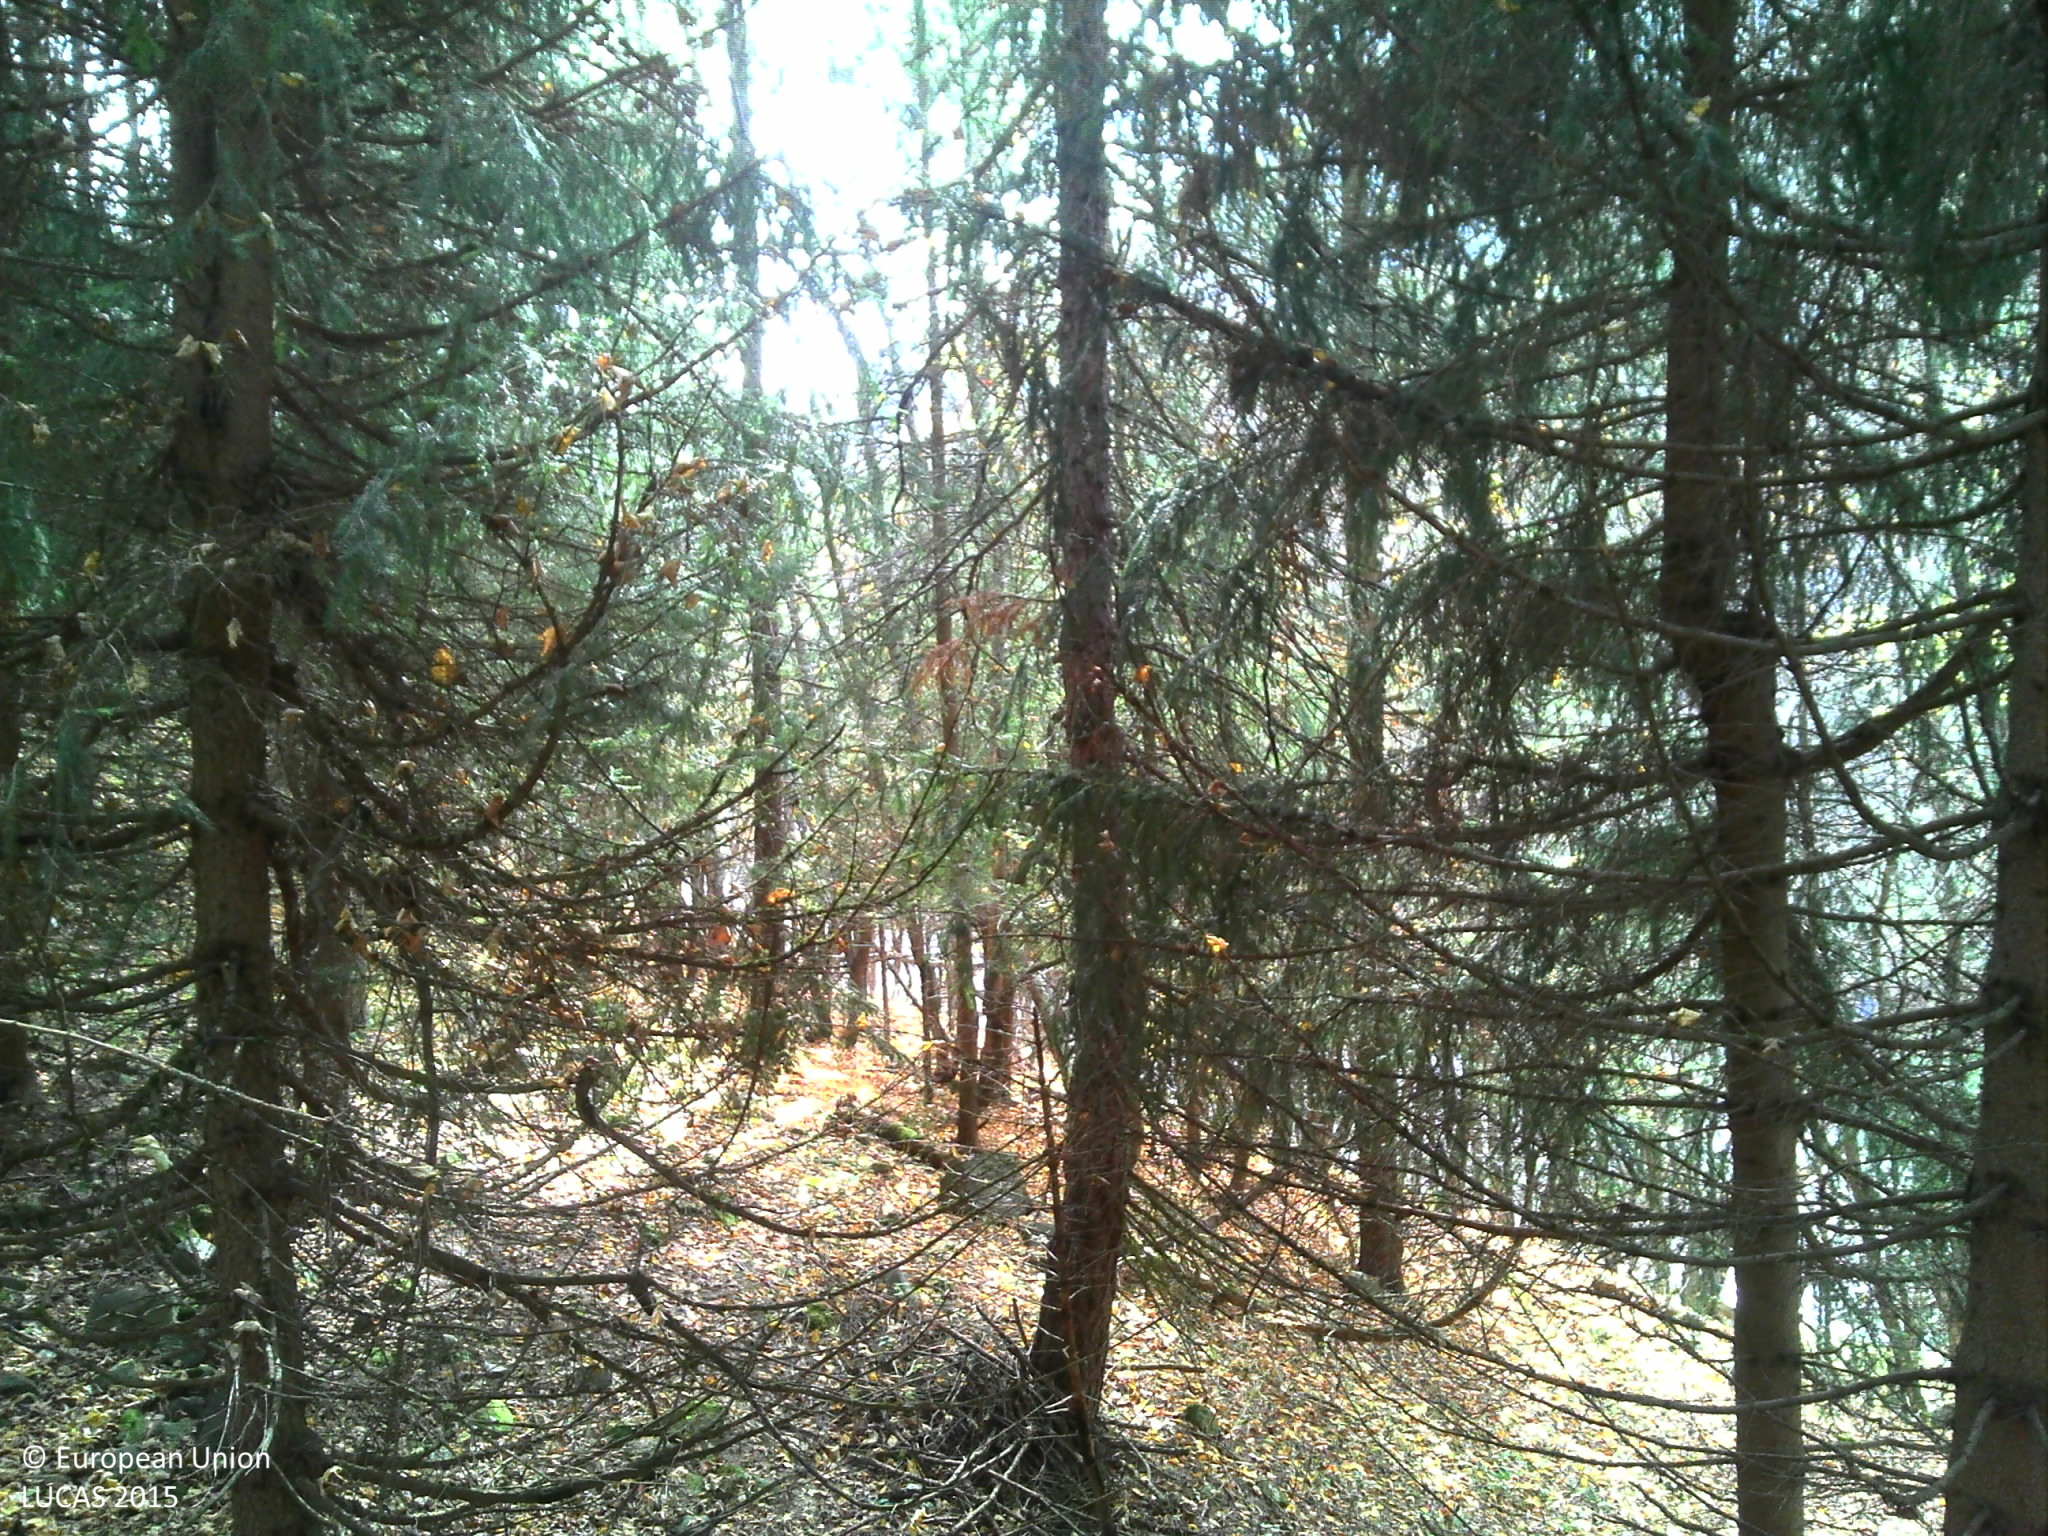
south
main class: Woodland
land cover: Other mixed woodland
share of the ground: > 75 %
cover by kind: coniferous forest trees 50 %, broadleaved forest trees 30 %, unconsolidated bare surface 15 %, shrubs 5 %
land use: Forestry
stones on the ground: < 10 %
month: October
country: FR
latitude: 45.1735
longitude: 6.4297
